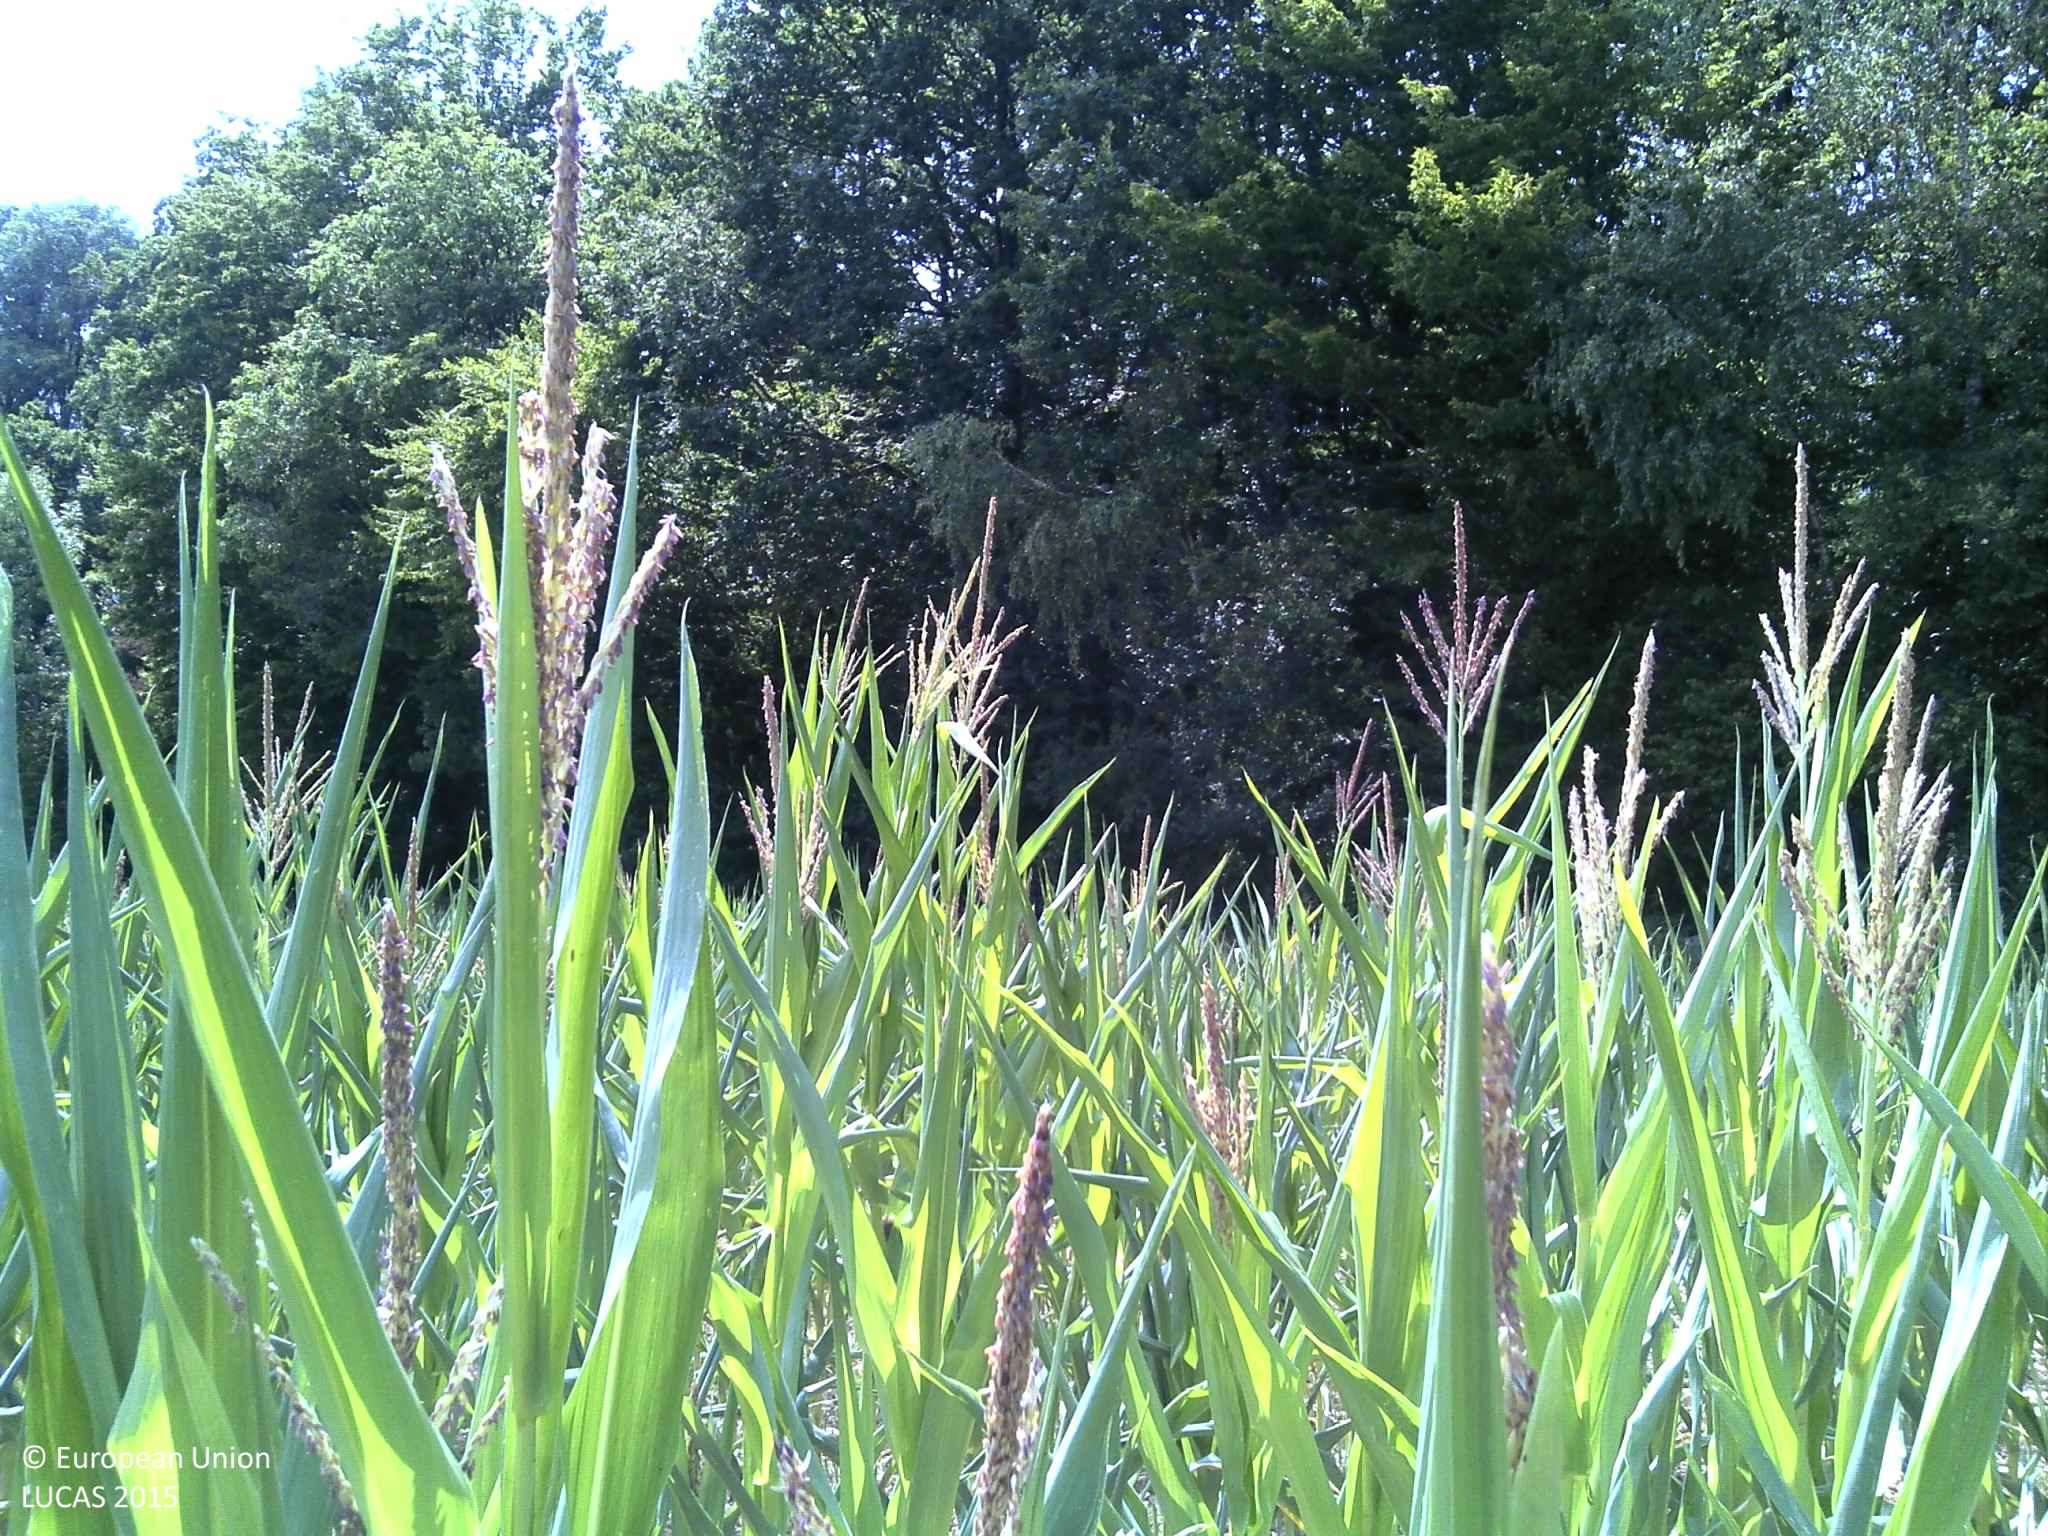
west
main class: Cropland
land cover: Maize
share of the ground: > 75 %
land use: Agriculture (excluding fallow land and kitchen gardens)
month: July
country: FR
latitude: 48.8608
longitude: 4.8589
